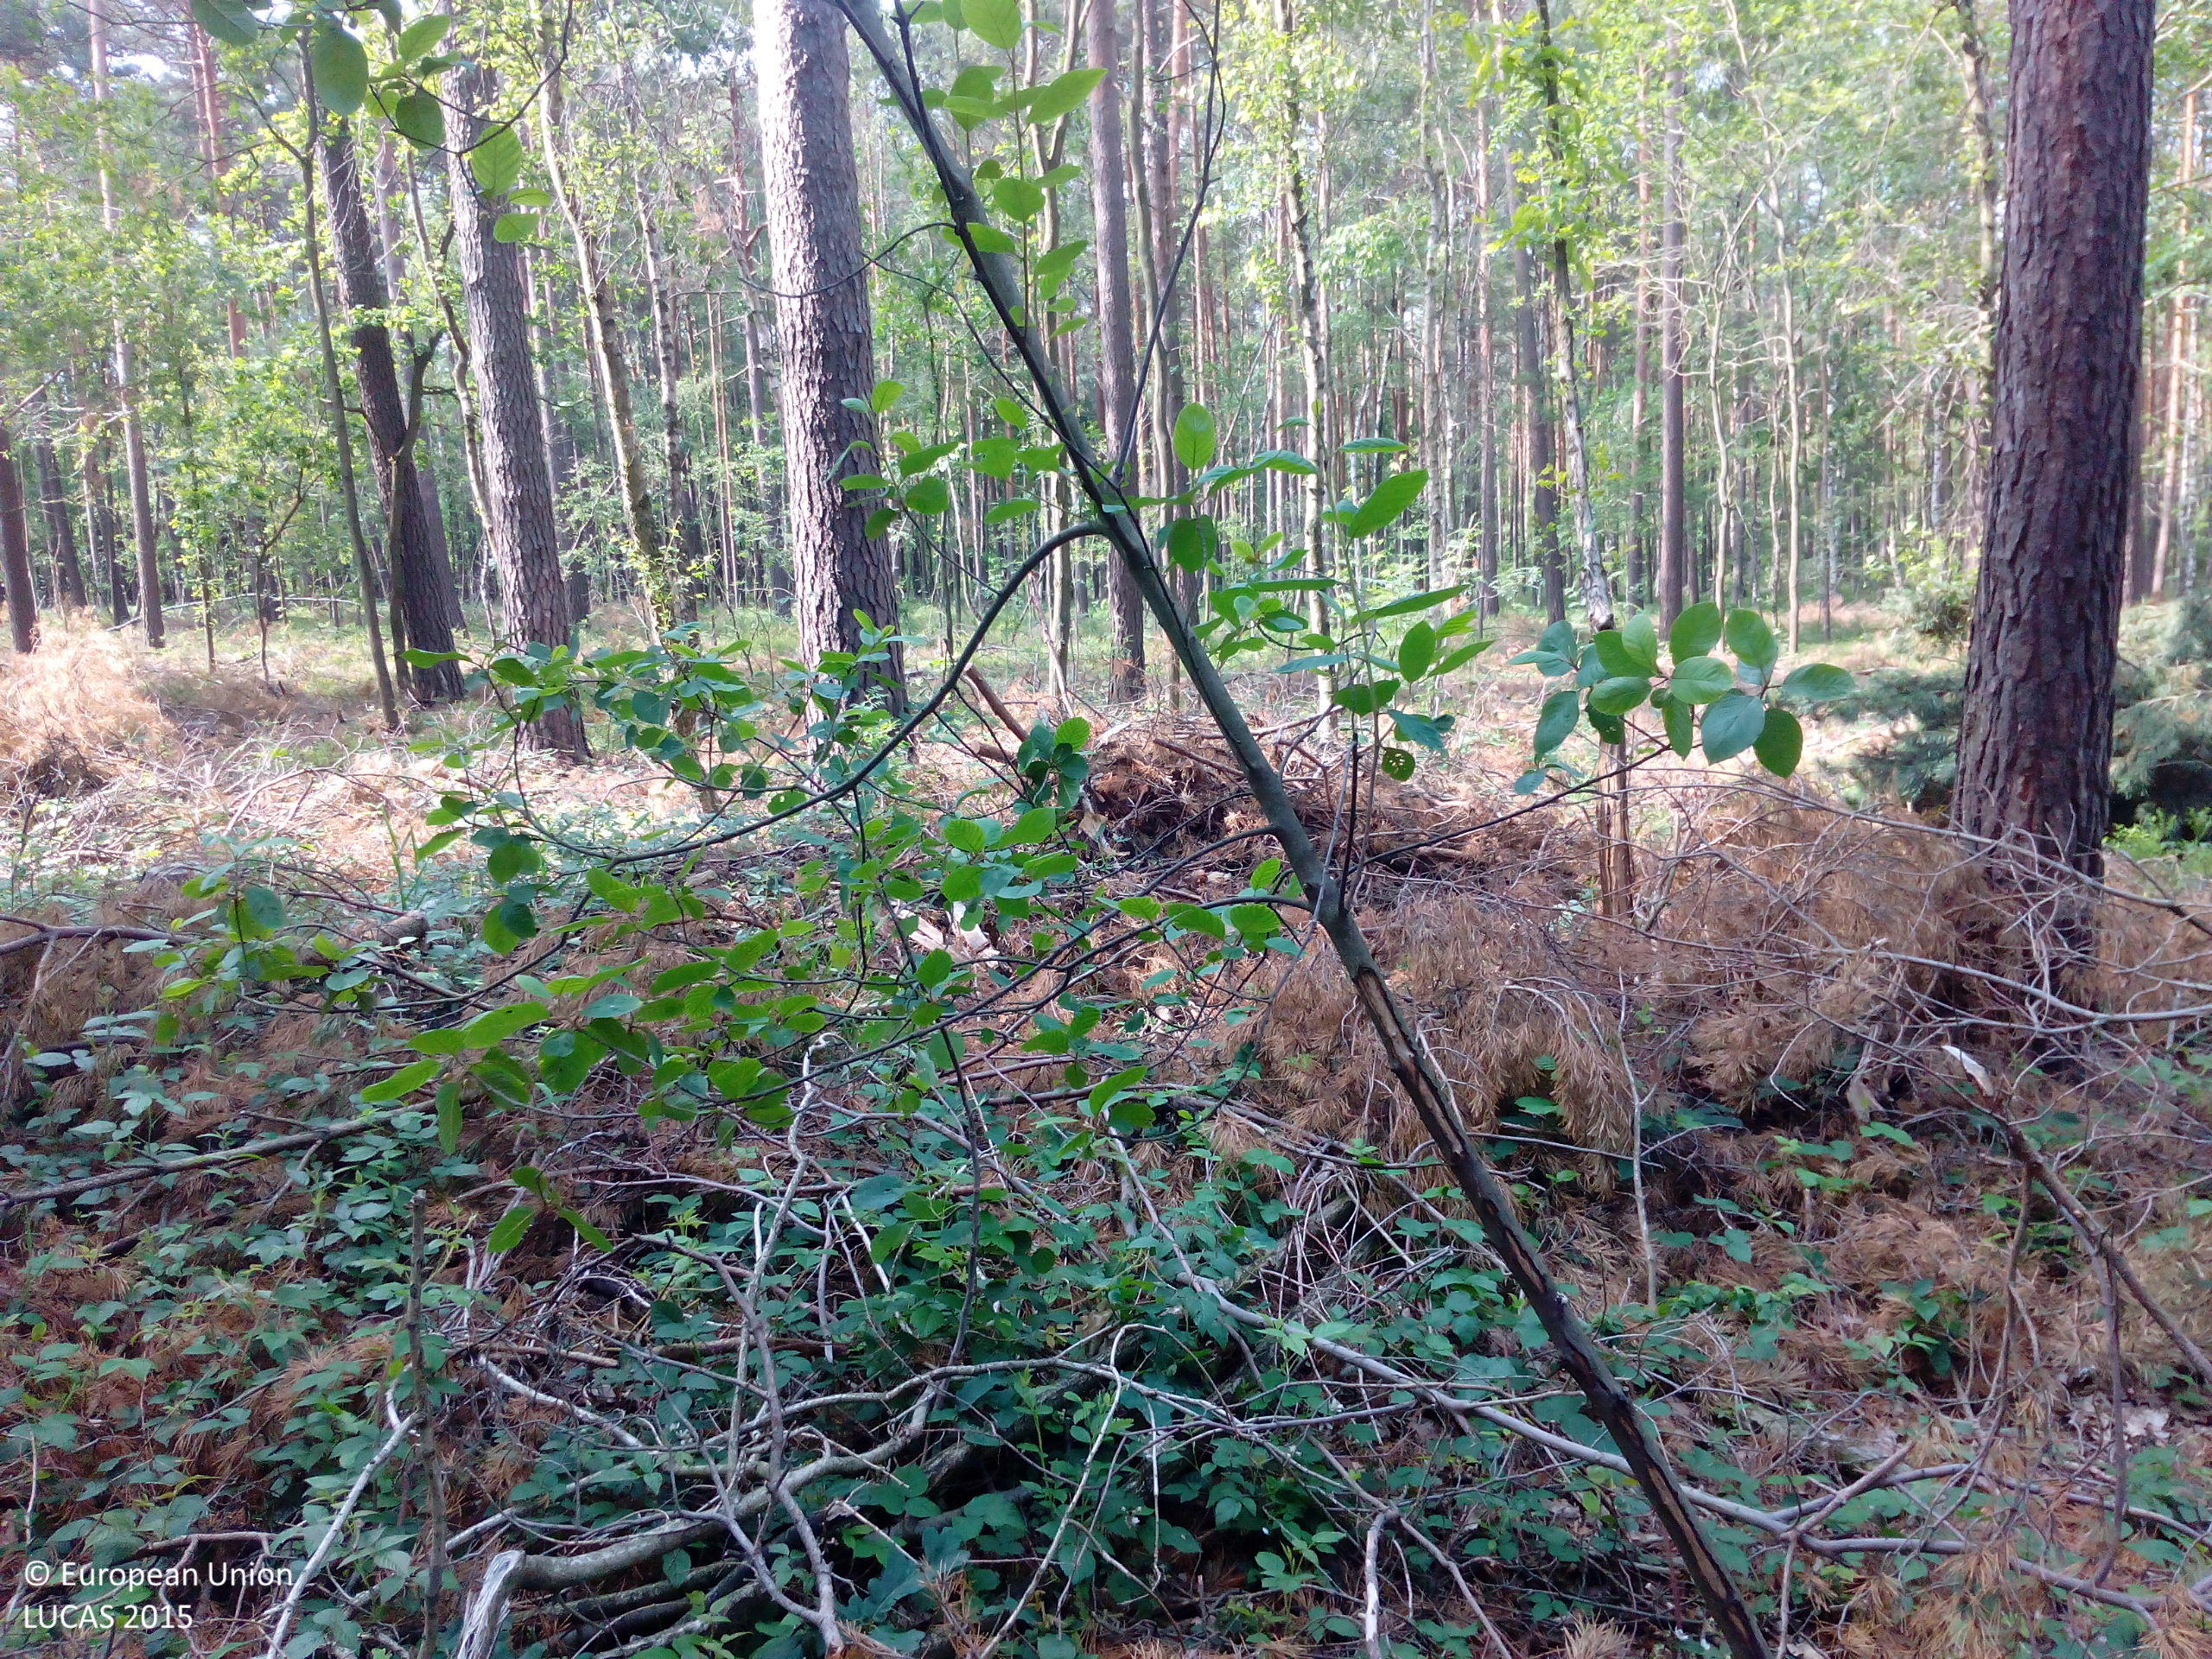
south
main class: Woodland
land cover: Pine dominated mixed woodland
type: hemiboreal forest and nemoral coniferous forest and mixed broadleaved-coniferous forest
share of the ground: 25 - 50 %
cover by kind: shrubs 35 %, coniferous forest trees 25 %, broadleaved forest trees 20 %, unconsolidated bare surface 20 %
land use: Forestry
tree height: > 5 m
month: June
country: DE
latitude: 51.2842
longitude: 14.0013
